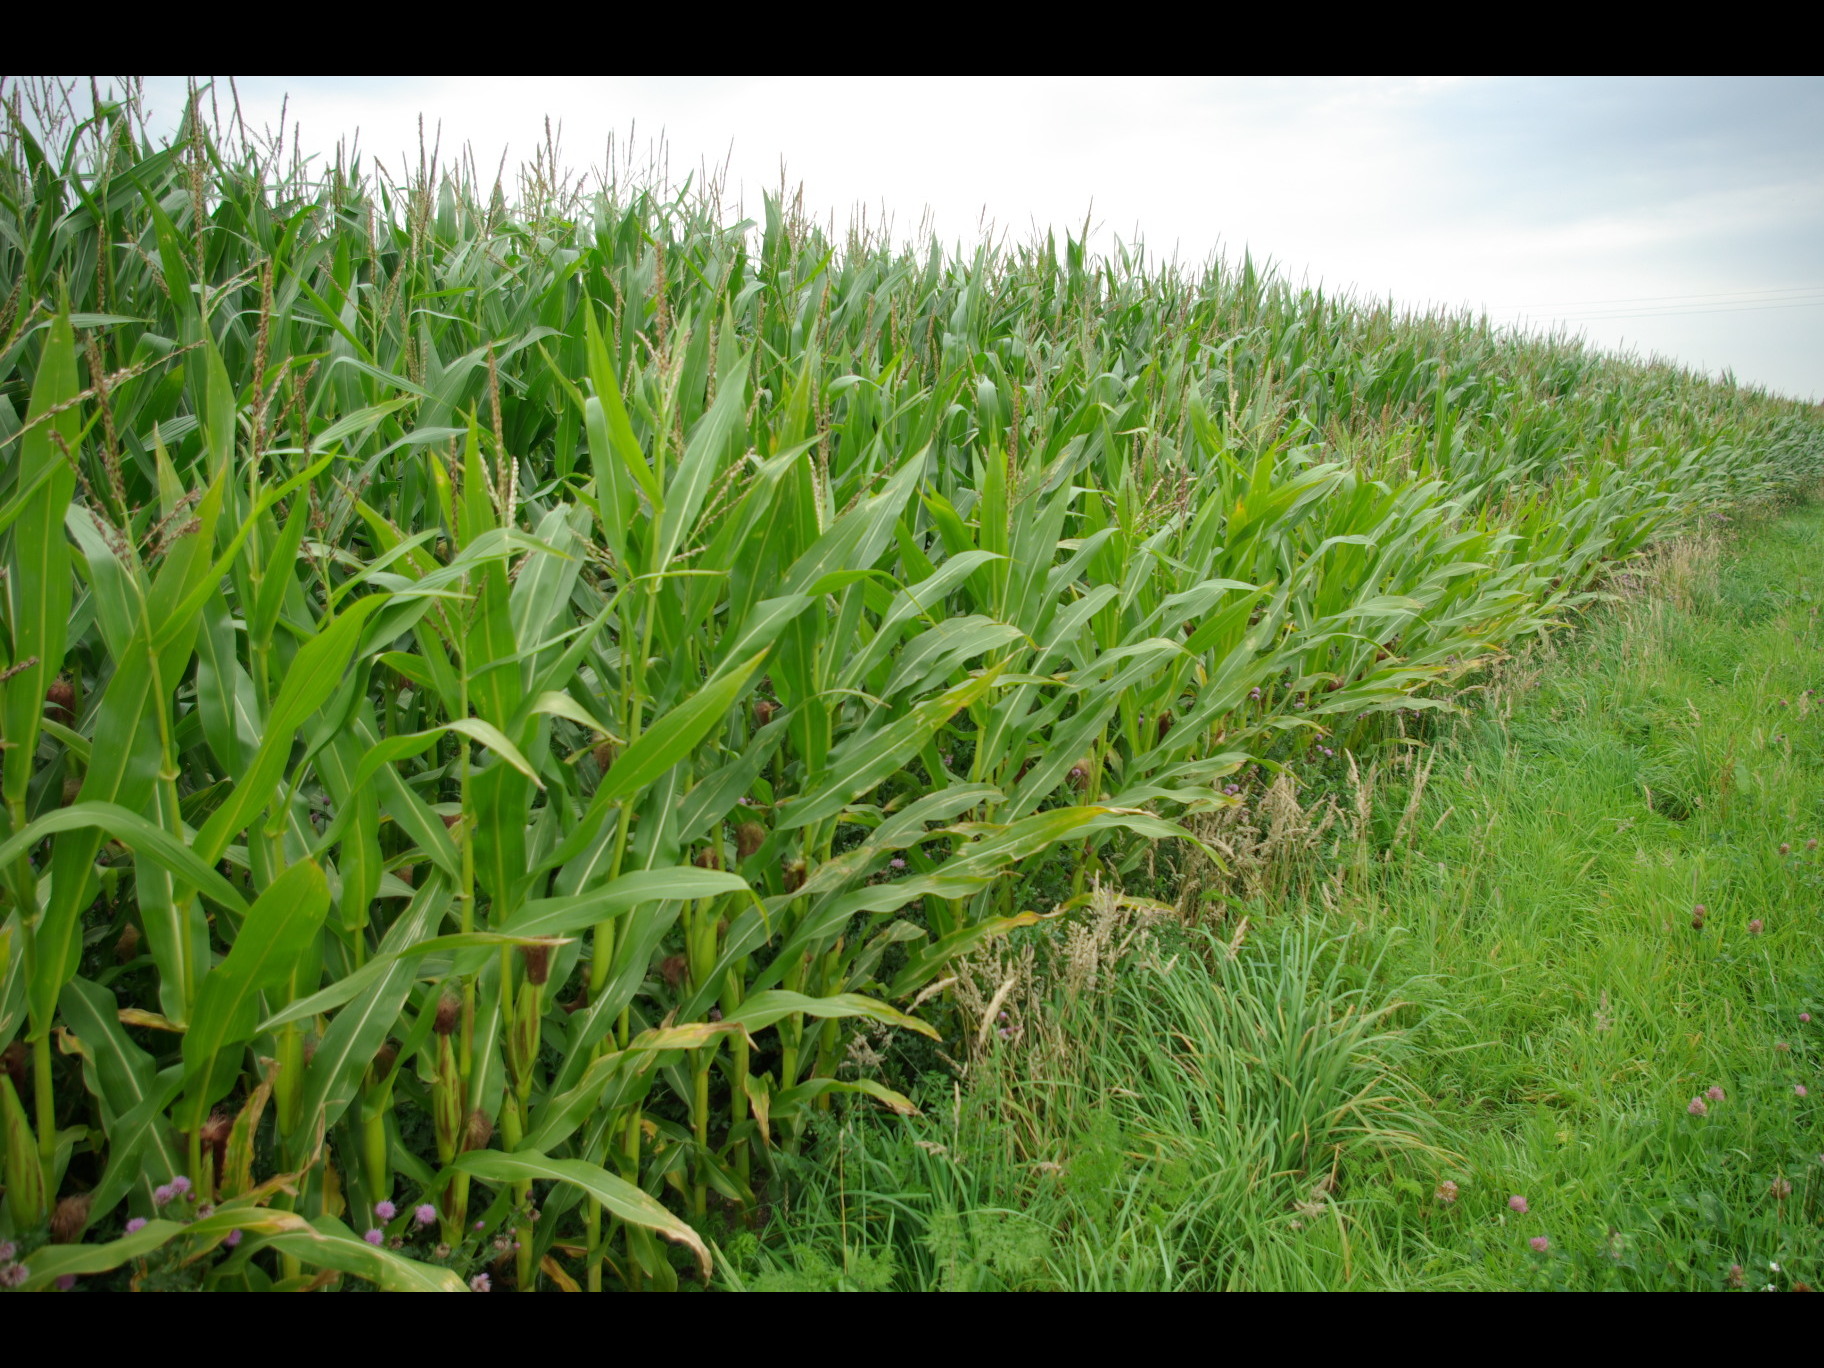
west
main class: Cropland
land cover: Maize
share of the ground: > 75 %
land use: Agriculture (excluding fallow land and kitchen gardens)
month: August
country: DE
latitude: 54.4963
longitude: 9.3057
